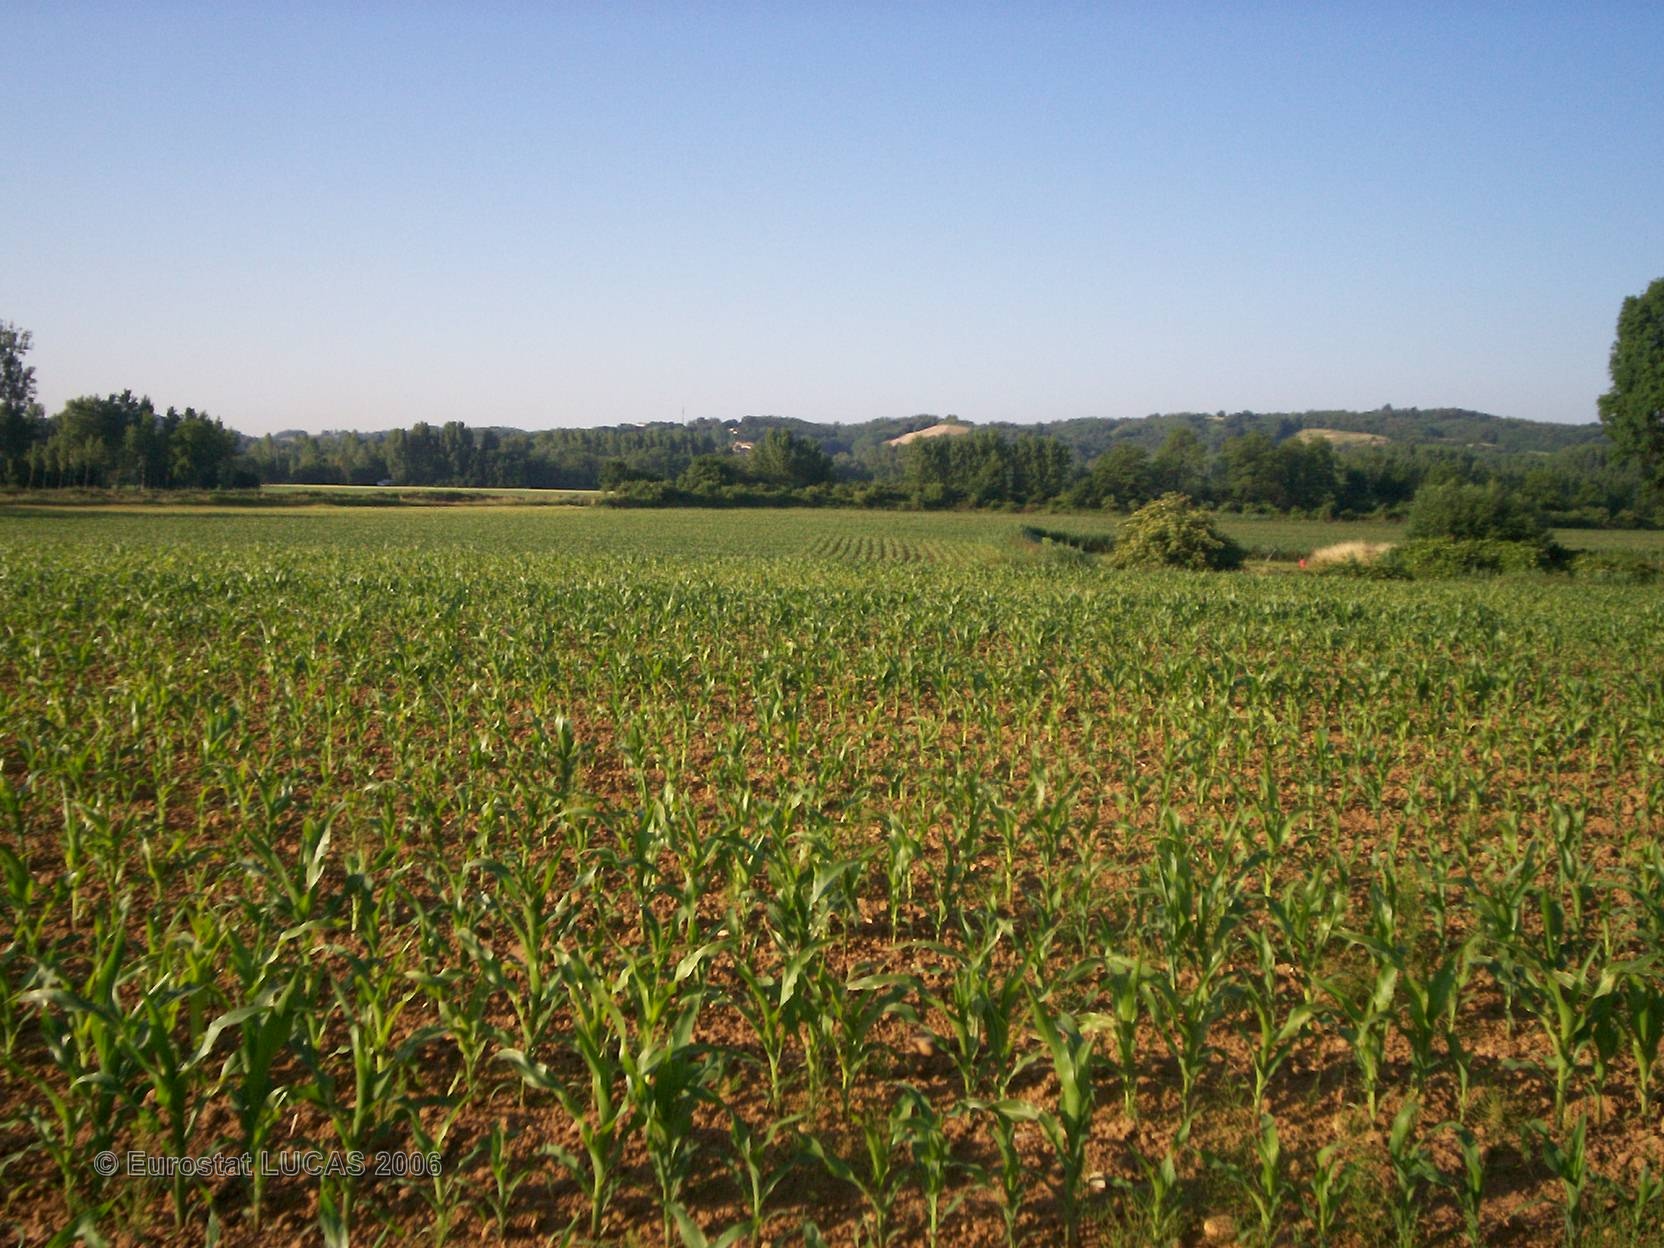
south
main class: Cropland
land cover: Maize
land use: Agriculture (excluding fallow land and kitchen gardens)
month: June
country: FR
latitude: 45.1814
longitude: 4.8764
